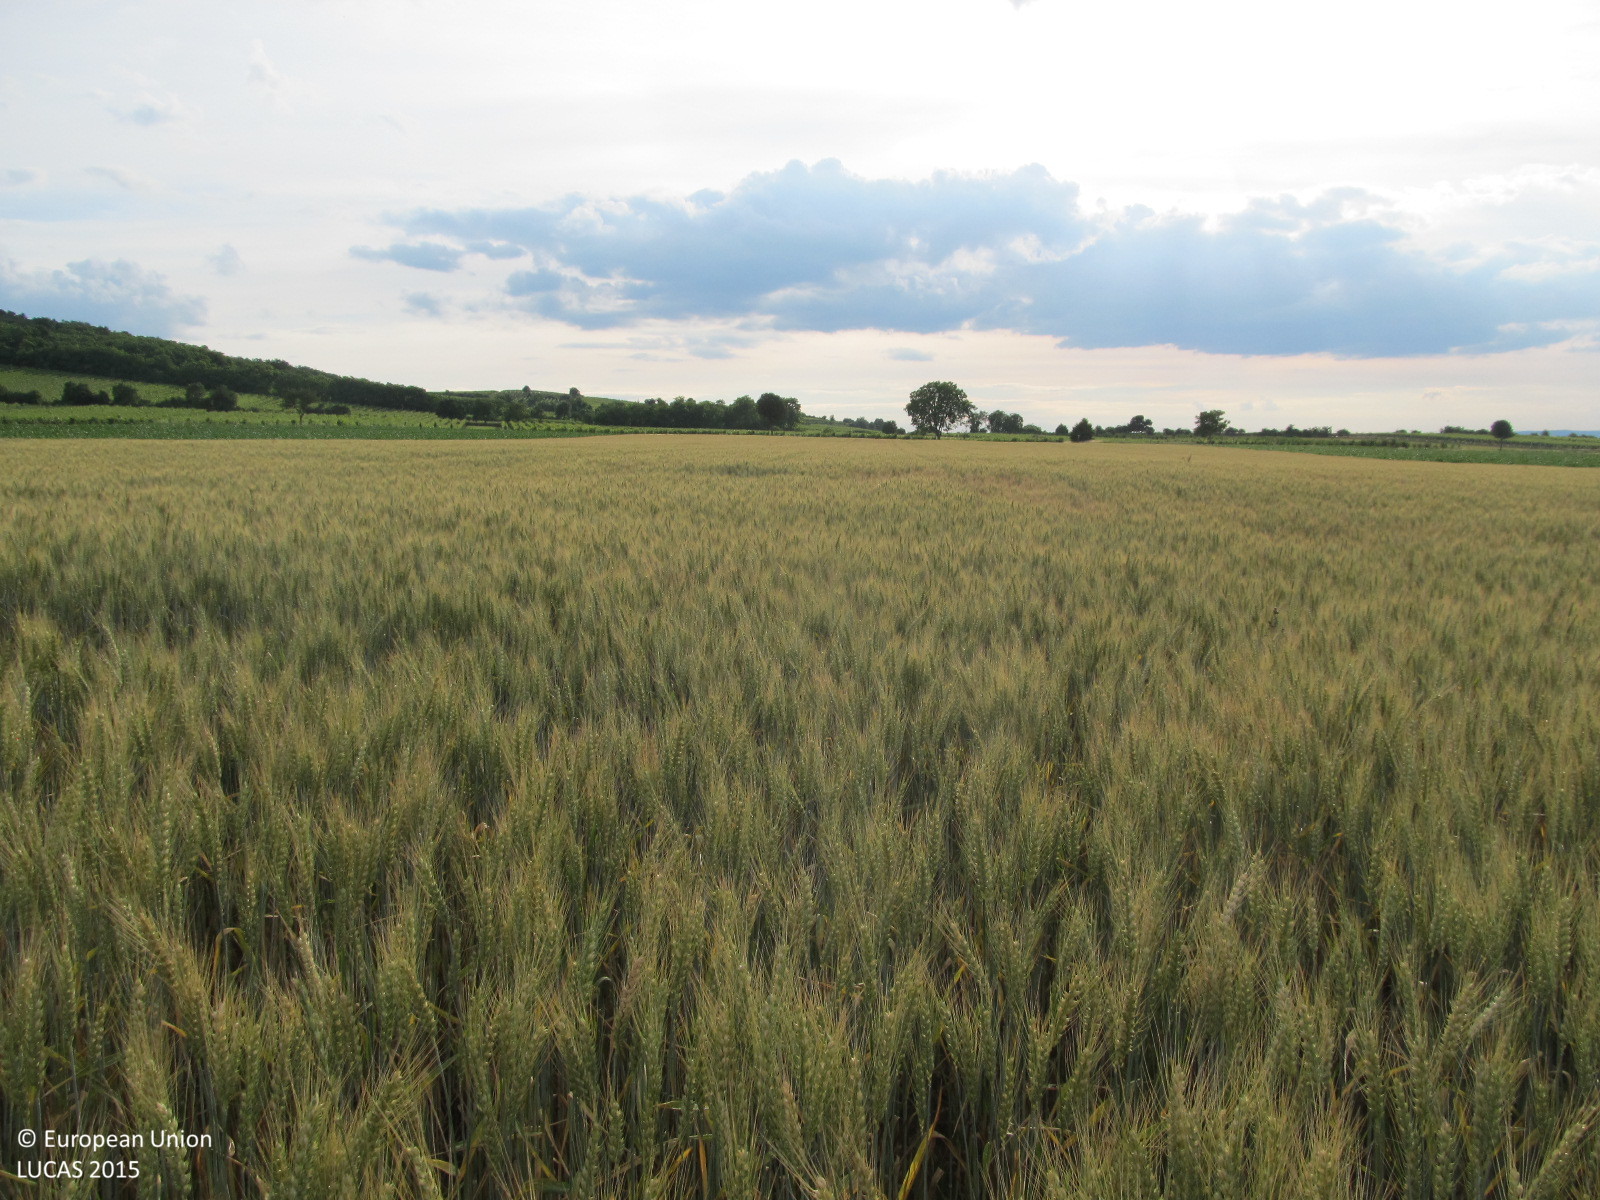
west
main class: Cropland
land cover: Common wheat
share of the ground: > 75 %
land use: Agriculture (excluding fallow land and kitchen gardens)
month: June
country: AT
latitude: 48.6844
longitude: 16.1309
